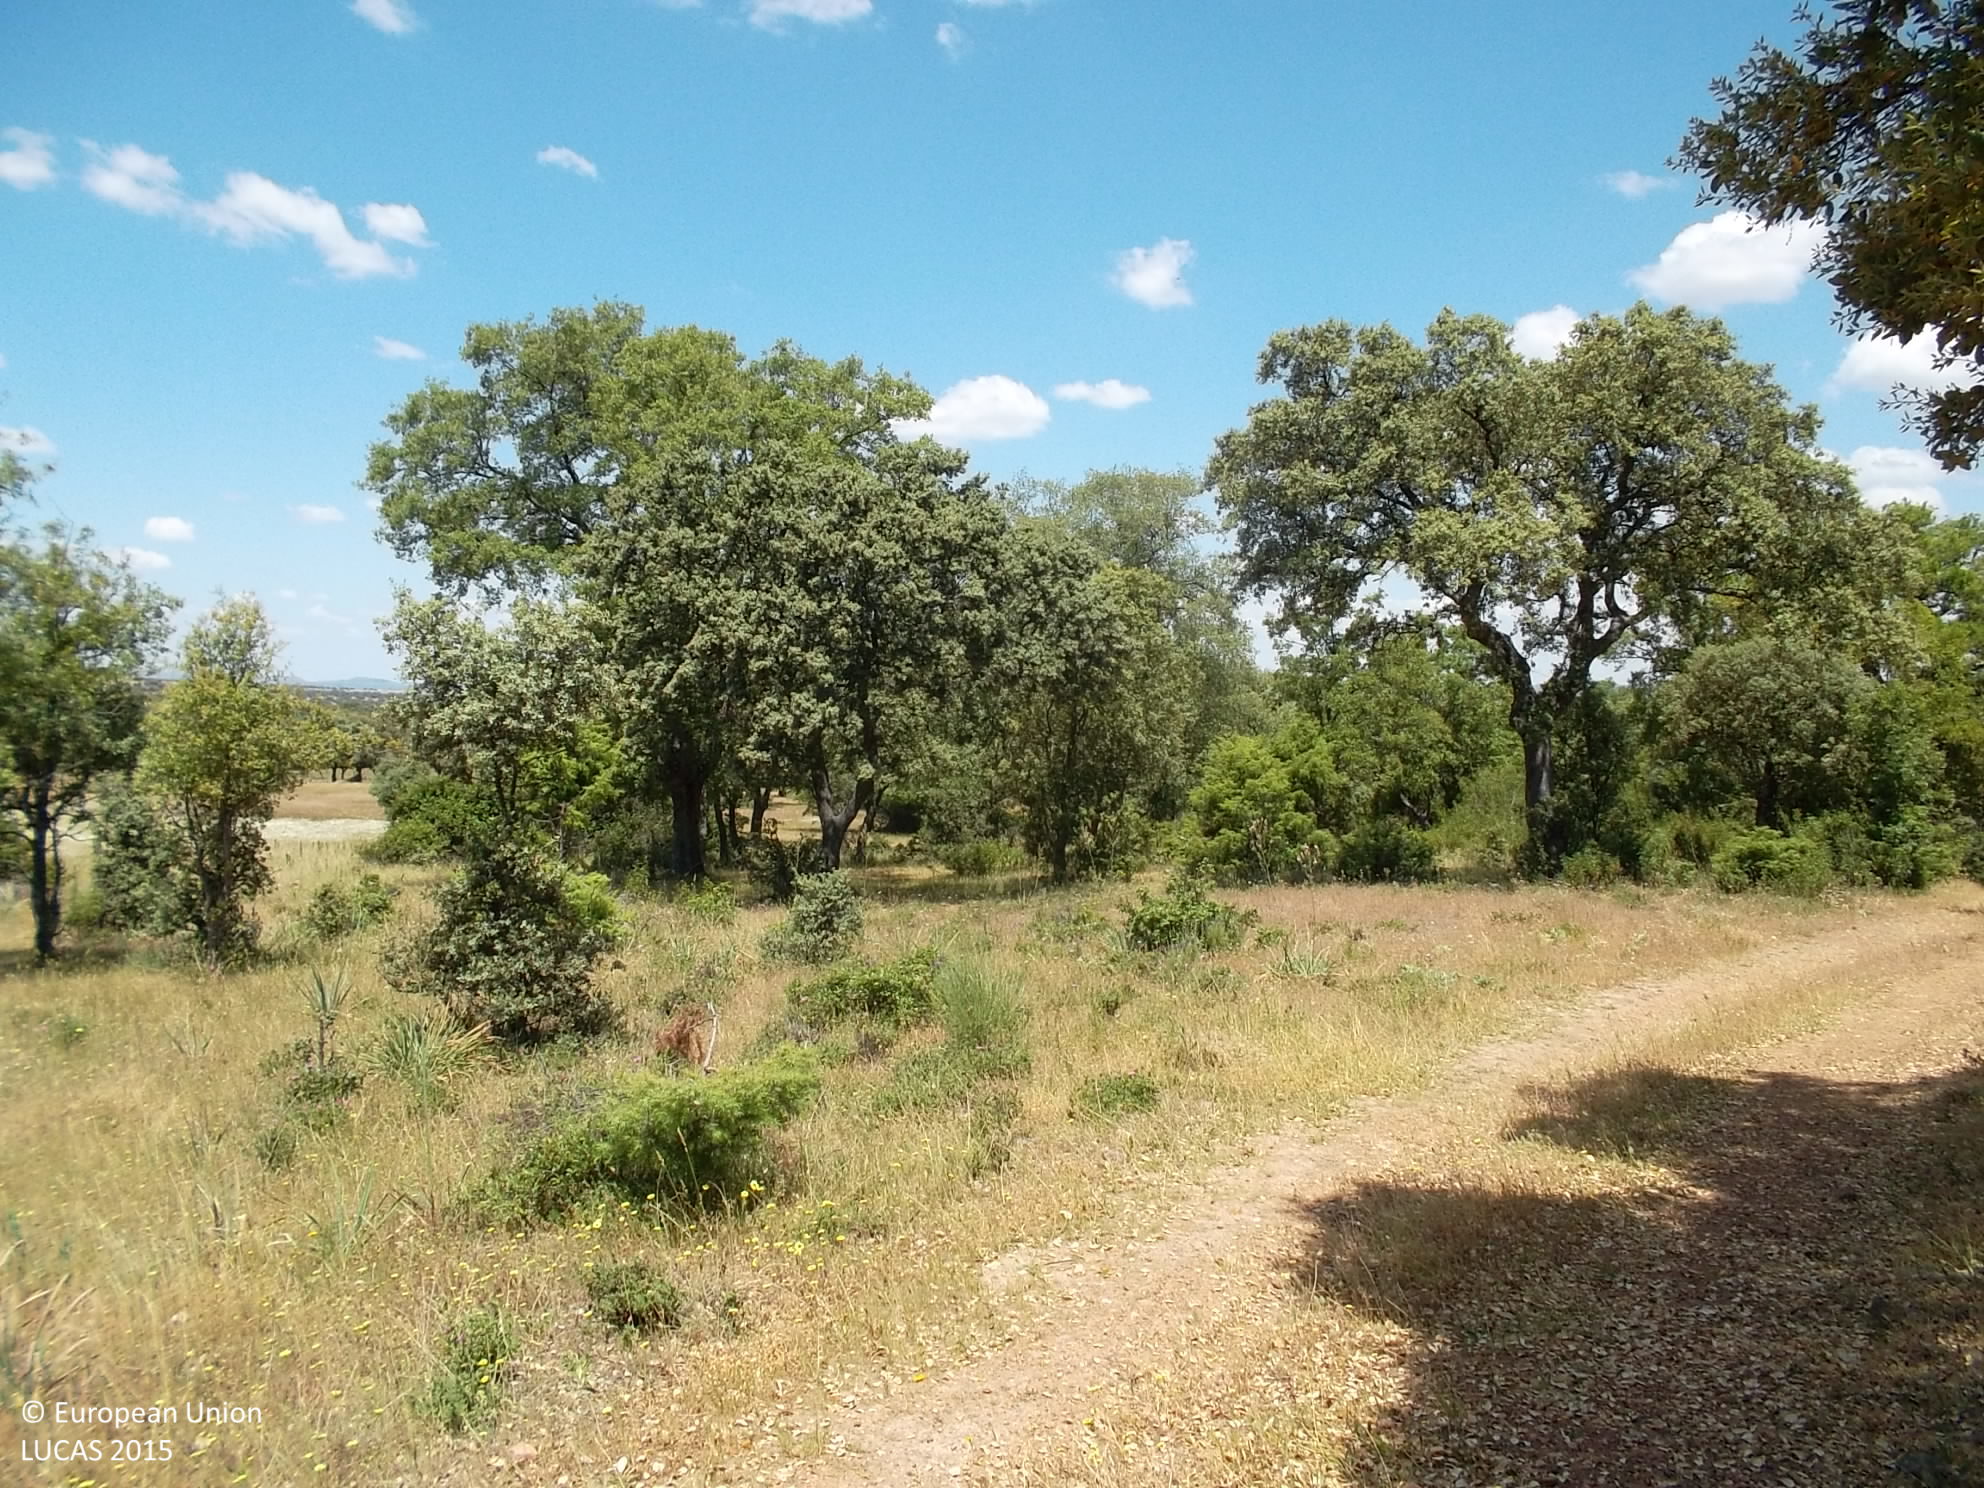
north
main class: Woodland
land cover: Broadleaved woodland
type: broadleaved evergreen forest
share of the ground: 25 - 50 %
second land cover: Spontaneously vegetated surfaces
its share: > 75 %
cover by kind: herbaceous plants 60 %, broadleaved forest trees 40 %
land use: Forestry
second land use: Agriculture (excluding fallow land and kitchen gardens)
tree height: > 5 m
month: May
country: ES
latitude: 38.5422
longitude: -4.3723
